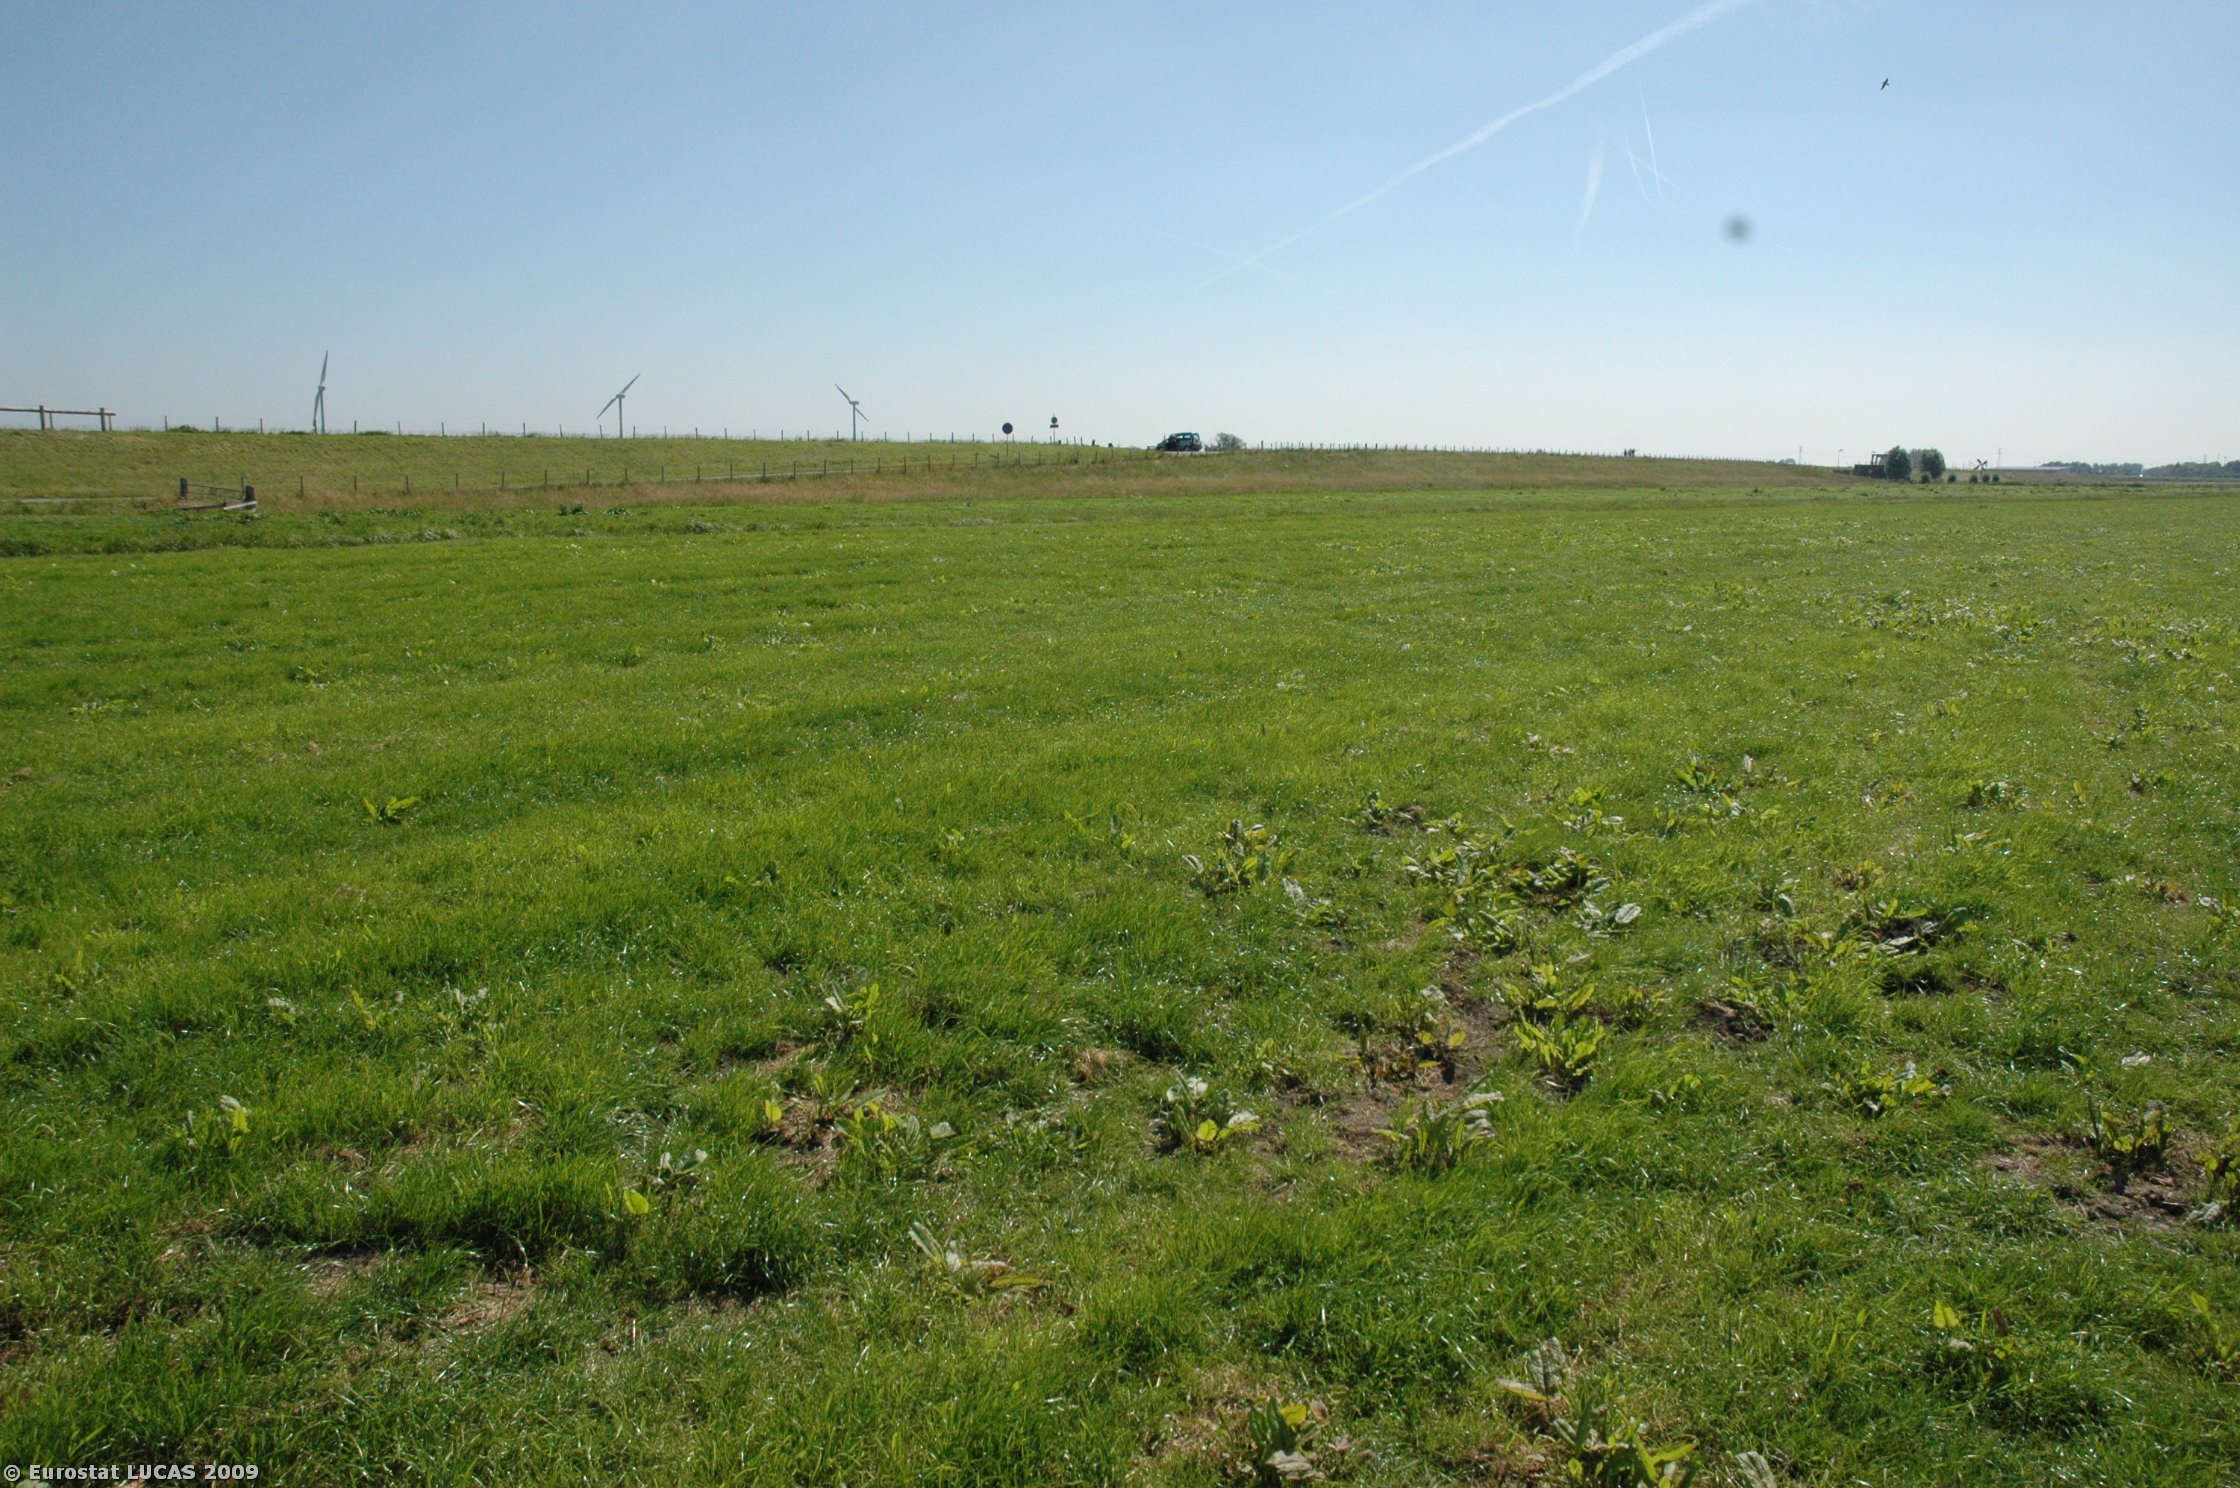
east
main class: Grassland
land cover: Grassland without tree/shrub cover
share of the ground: > 75 %
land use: Agriculture (excluding fallow land and kitchen gardens)
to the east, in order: Grassland without tree/shrub cover; Ditches and canals; Grassland without tree/shrub cover; Ditches and canals; Grassland without tree/shrub cover; Fences; Grass margins; Paved roads, cycling and walking lanes; Grassland without tree/shrub cover; Tracks; Grass margins; Fences; Grassland without tree/shrub cover; Ditches and canals; Grassland without tree/shrub cover; Inland water bodies
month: June
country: NL
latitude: 52.2685
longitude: 5.3528
